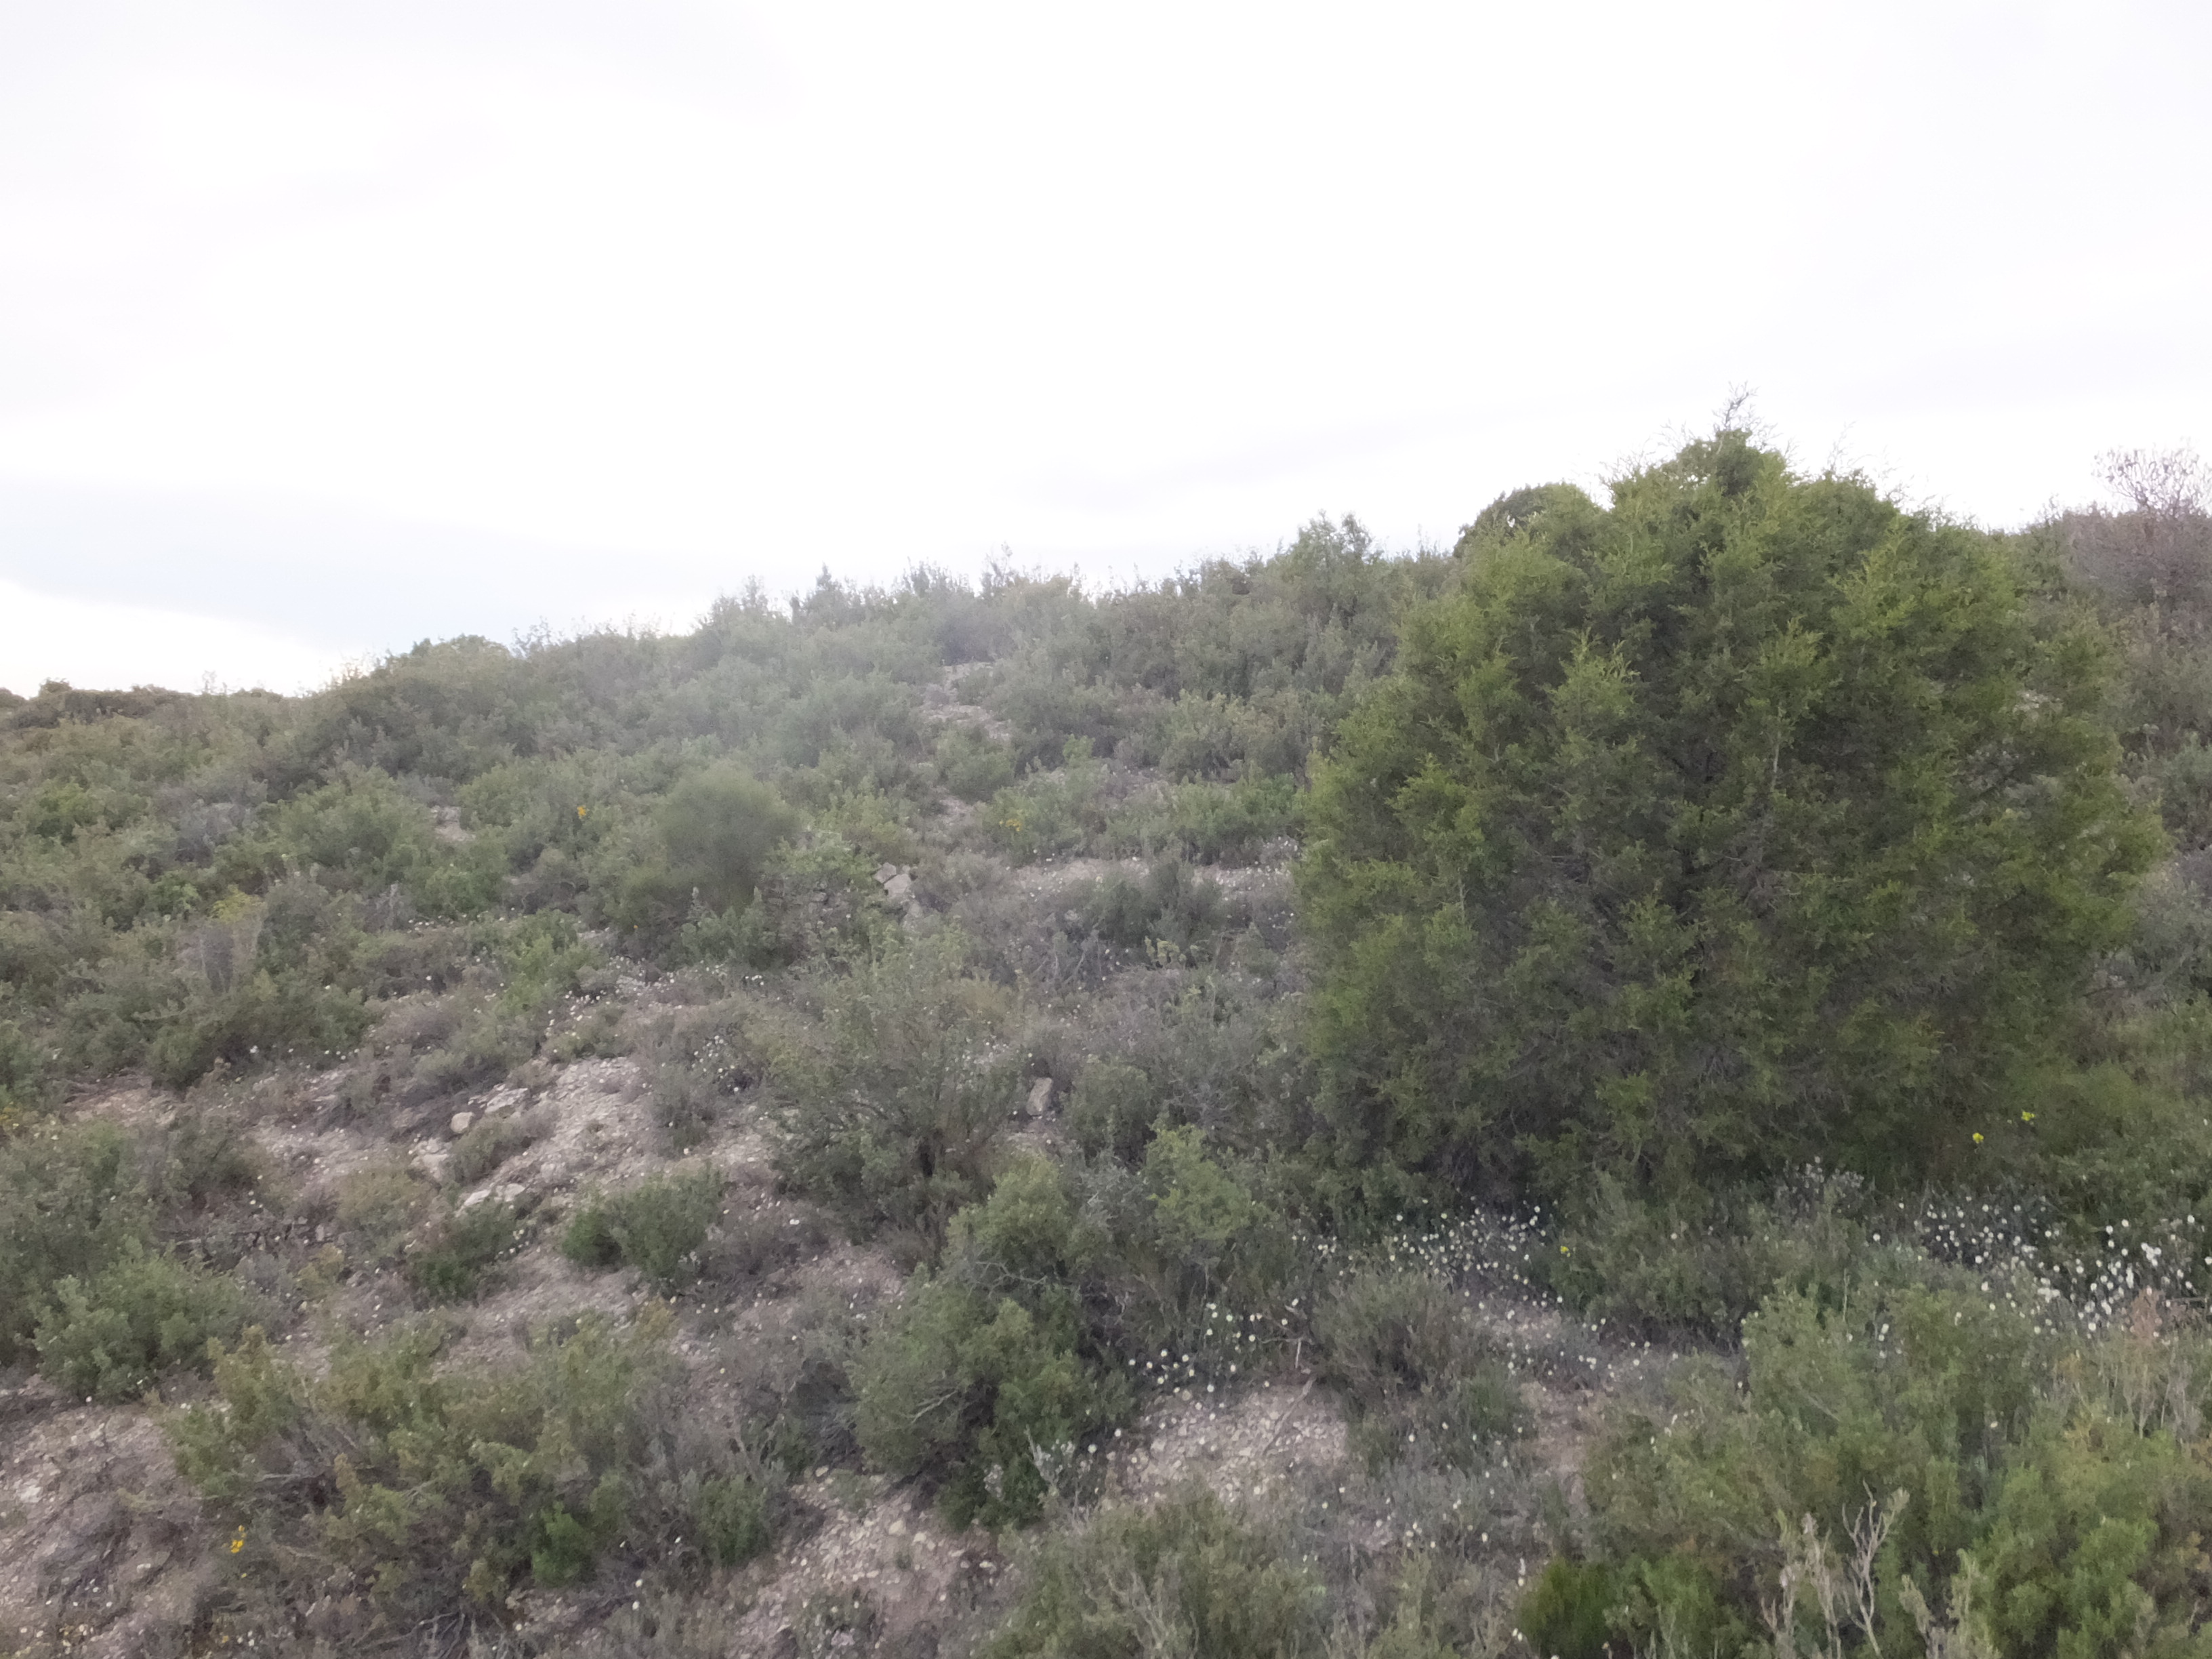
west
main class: Shrubland
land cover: Shrubland with sparse tree cover
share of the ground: > 75 %
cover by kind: shrubs 95 %, coniferous forest trees 5 %
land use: Semi-natural and natural areas not in use
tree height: < 5 m
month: April
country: ES
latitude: 41.6357
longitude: -0.3055
